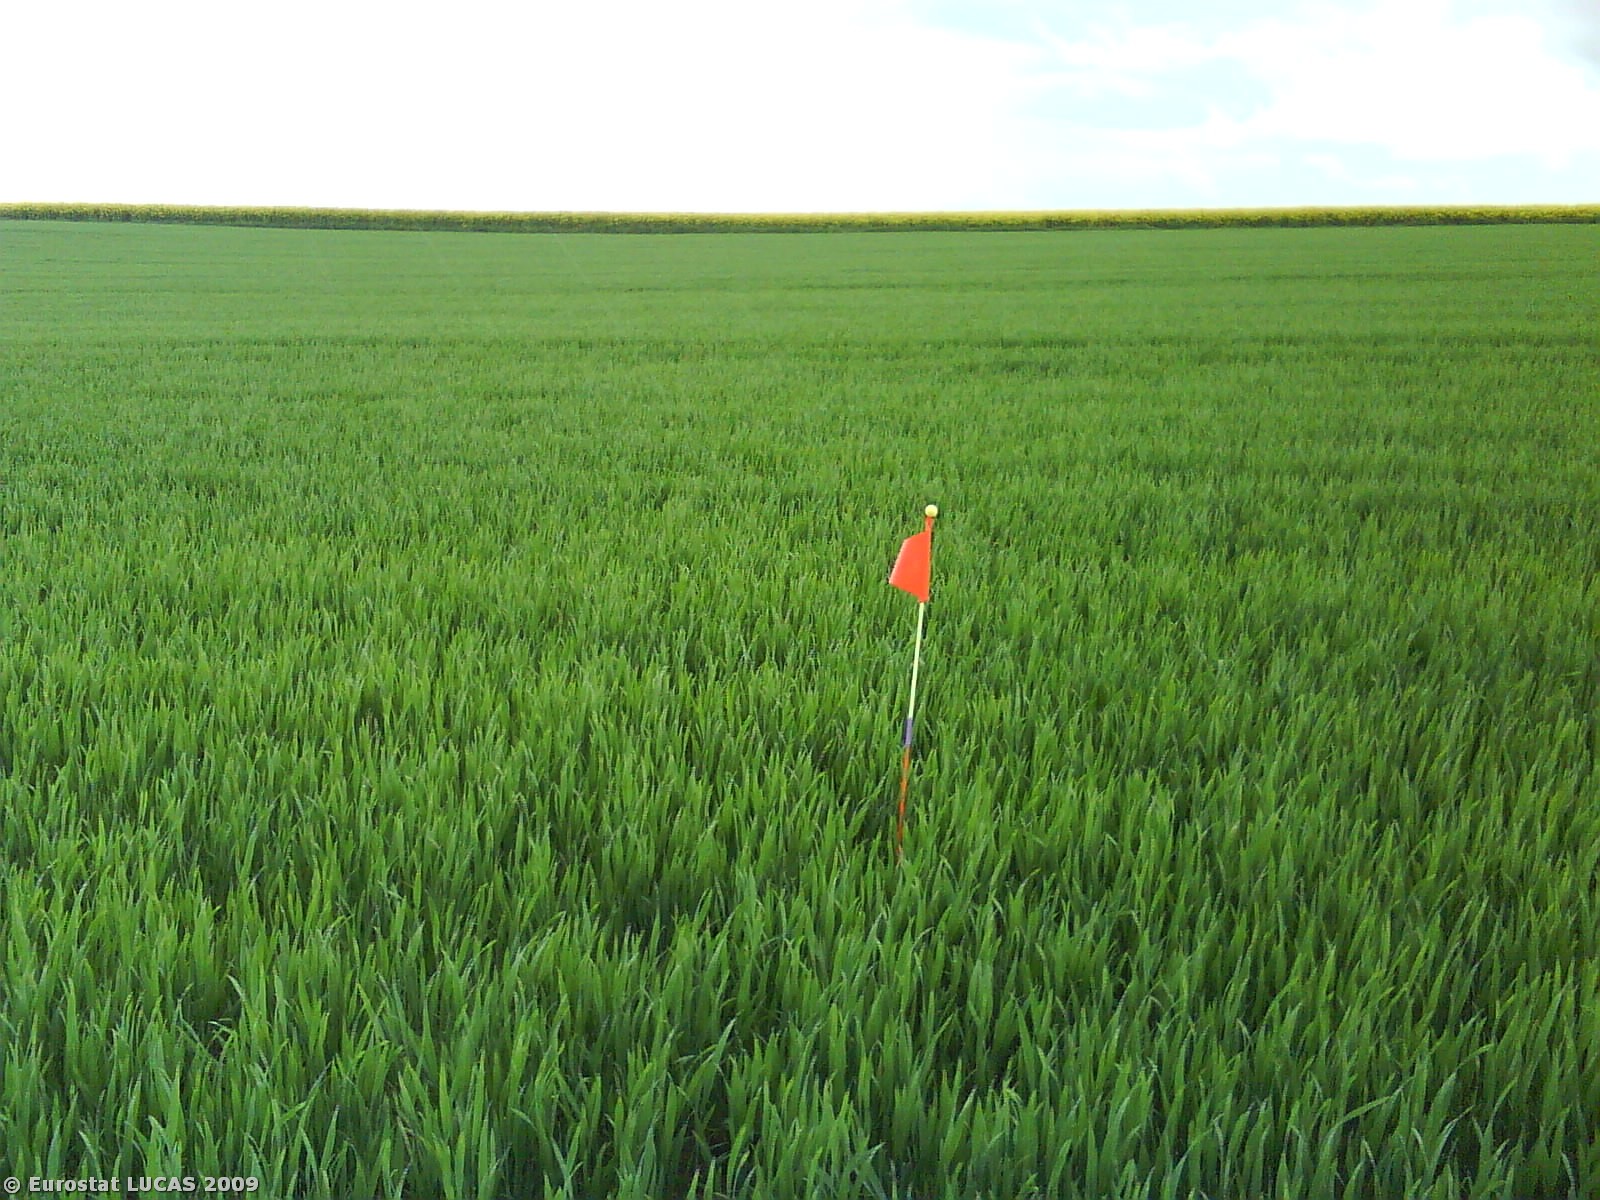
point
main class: Cropland
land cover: Common wheat
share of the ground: > 75 %
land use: Agriculture (excluding fallow land and kitchen gardens)
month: May
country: DK
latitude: 56.4031
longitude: 10.2751
